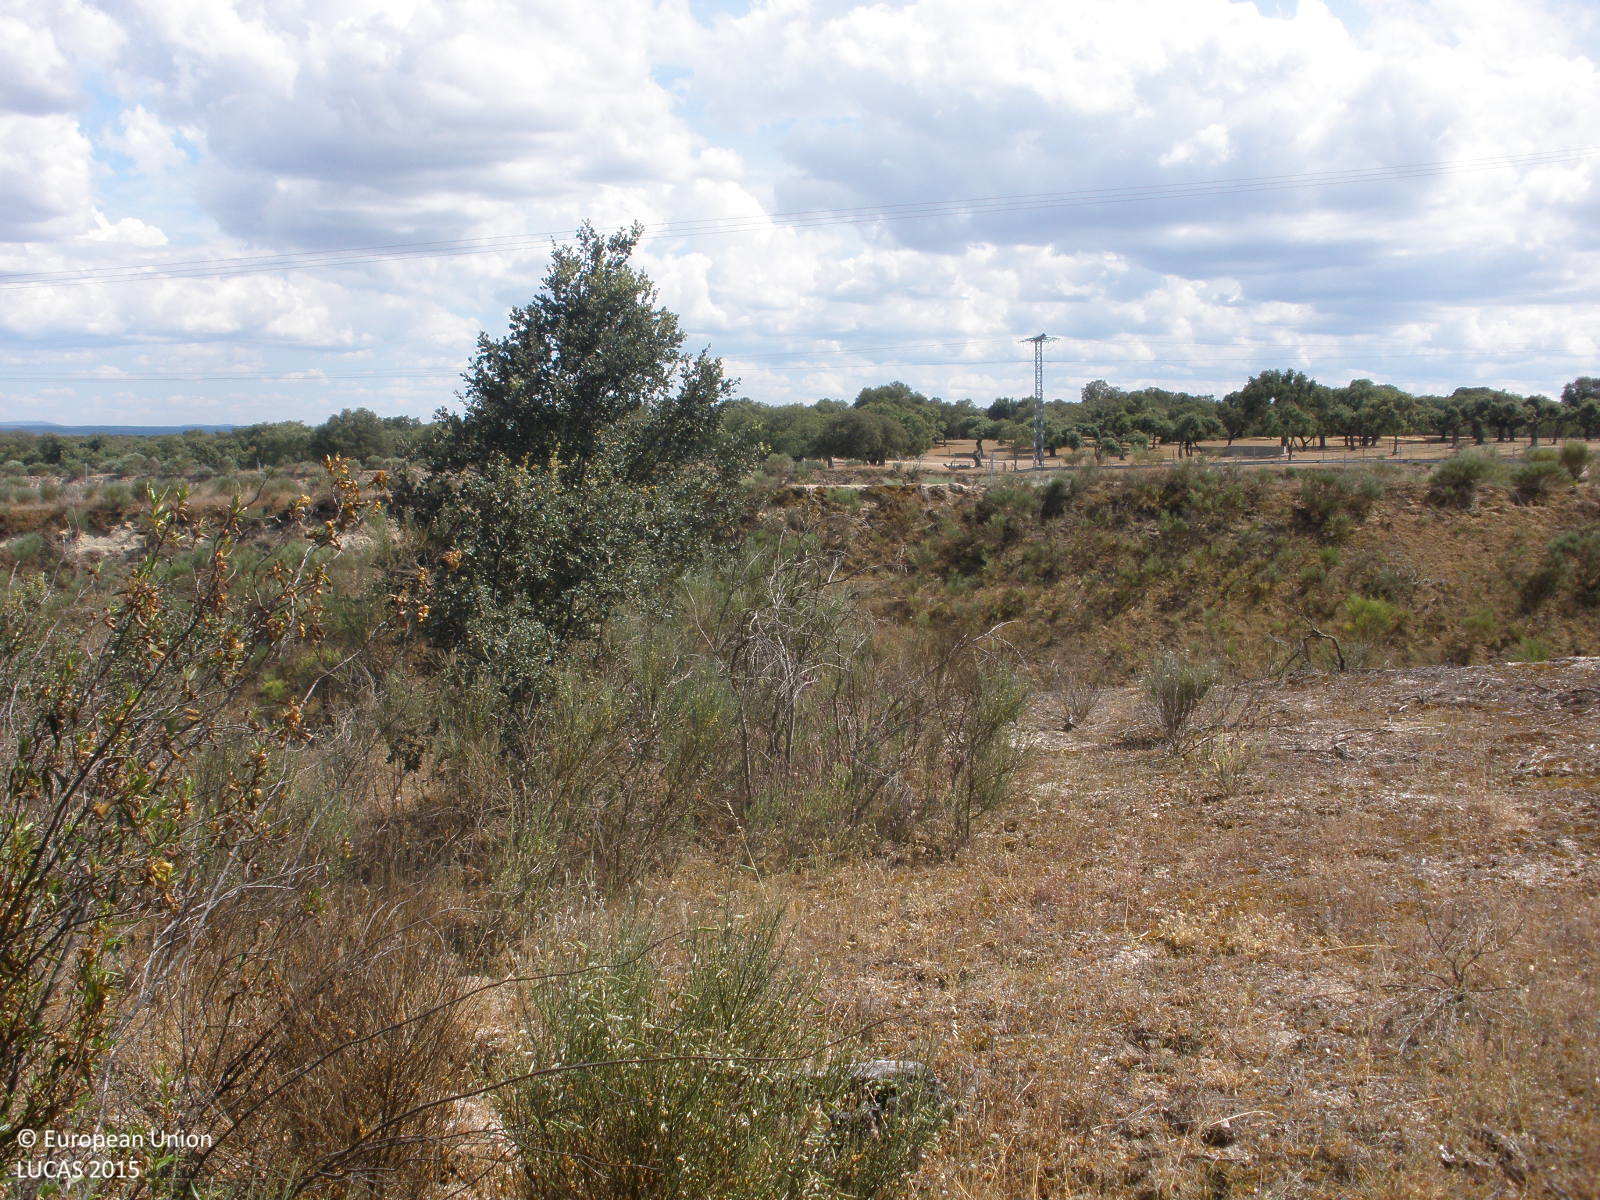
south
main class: Woodland
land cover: Broadleaved woodland
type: broadleaved evergreen forest
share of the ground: > 75 %
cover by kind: shrubs 50 %, broadleaved forest trees 40 %, herbaceous plants 10 %
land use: Semi-natural and natural areas not in use
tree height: > 5 m
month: June
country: ES
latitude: 40.5941
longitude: -6.6952
